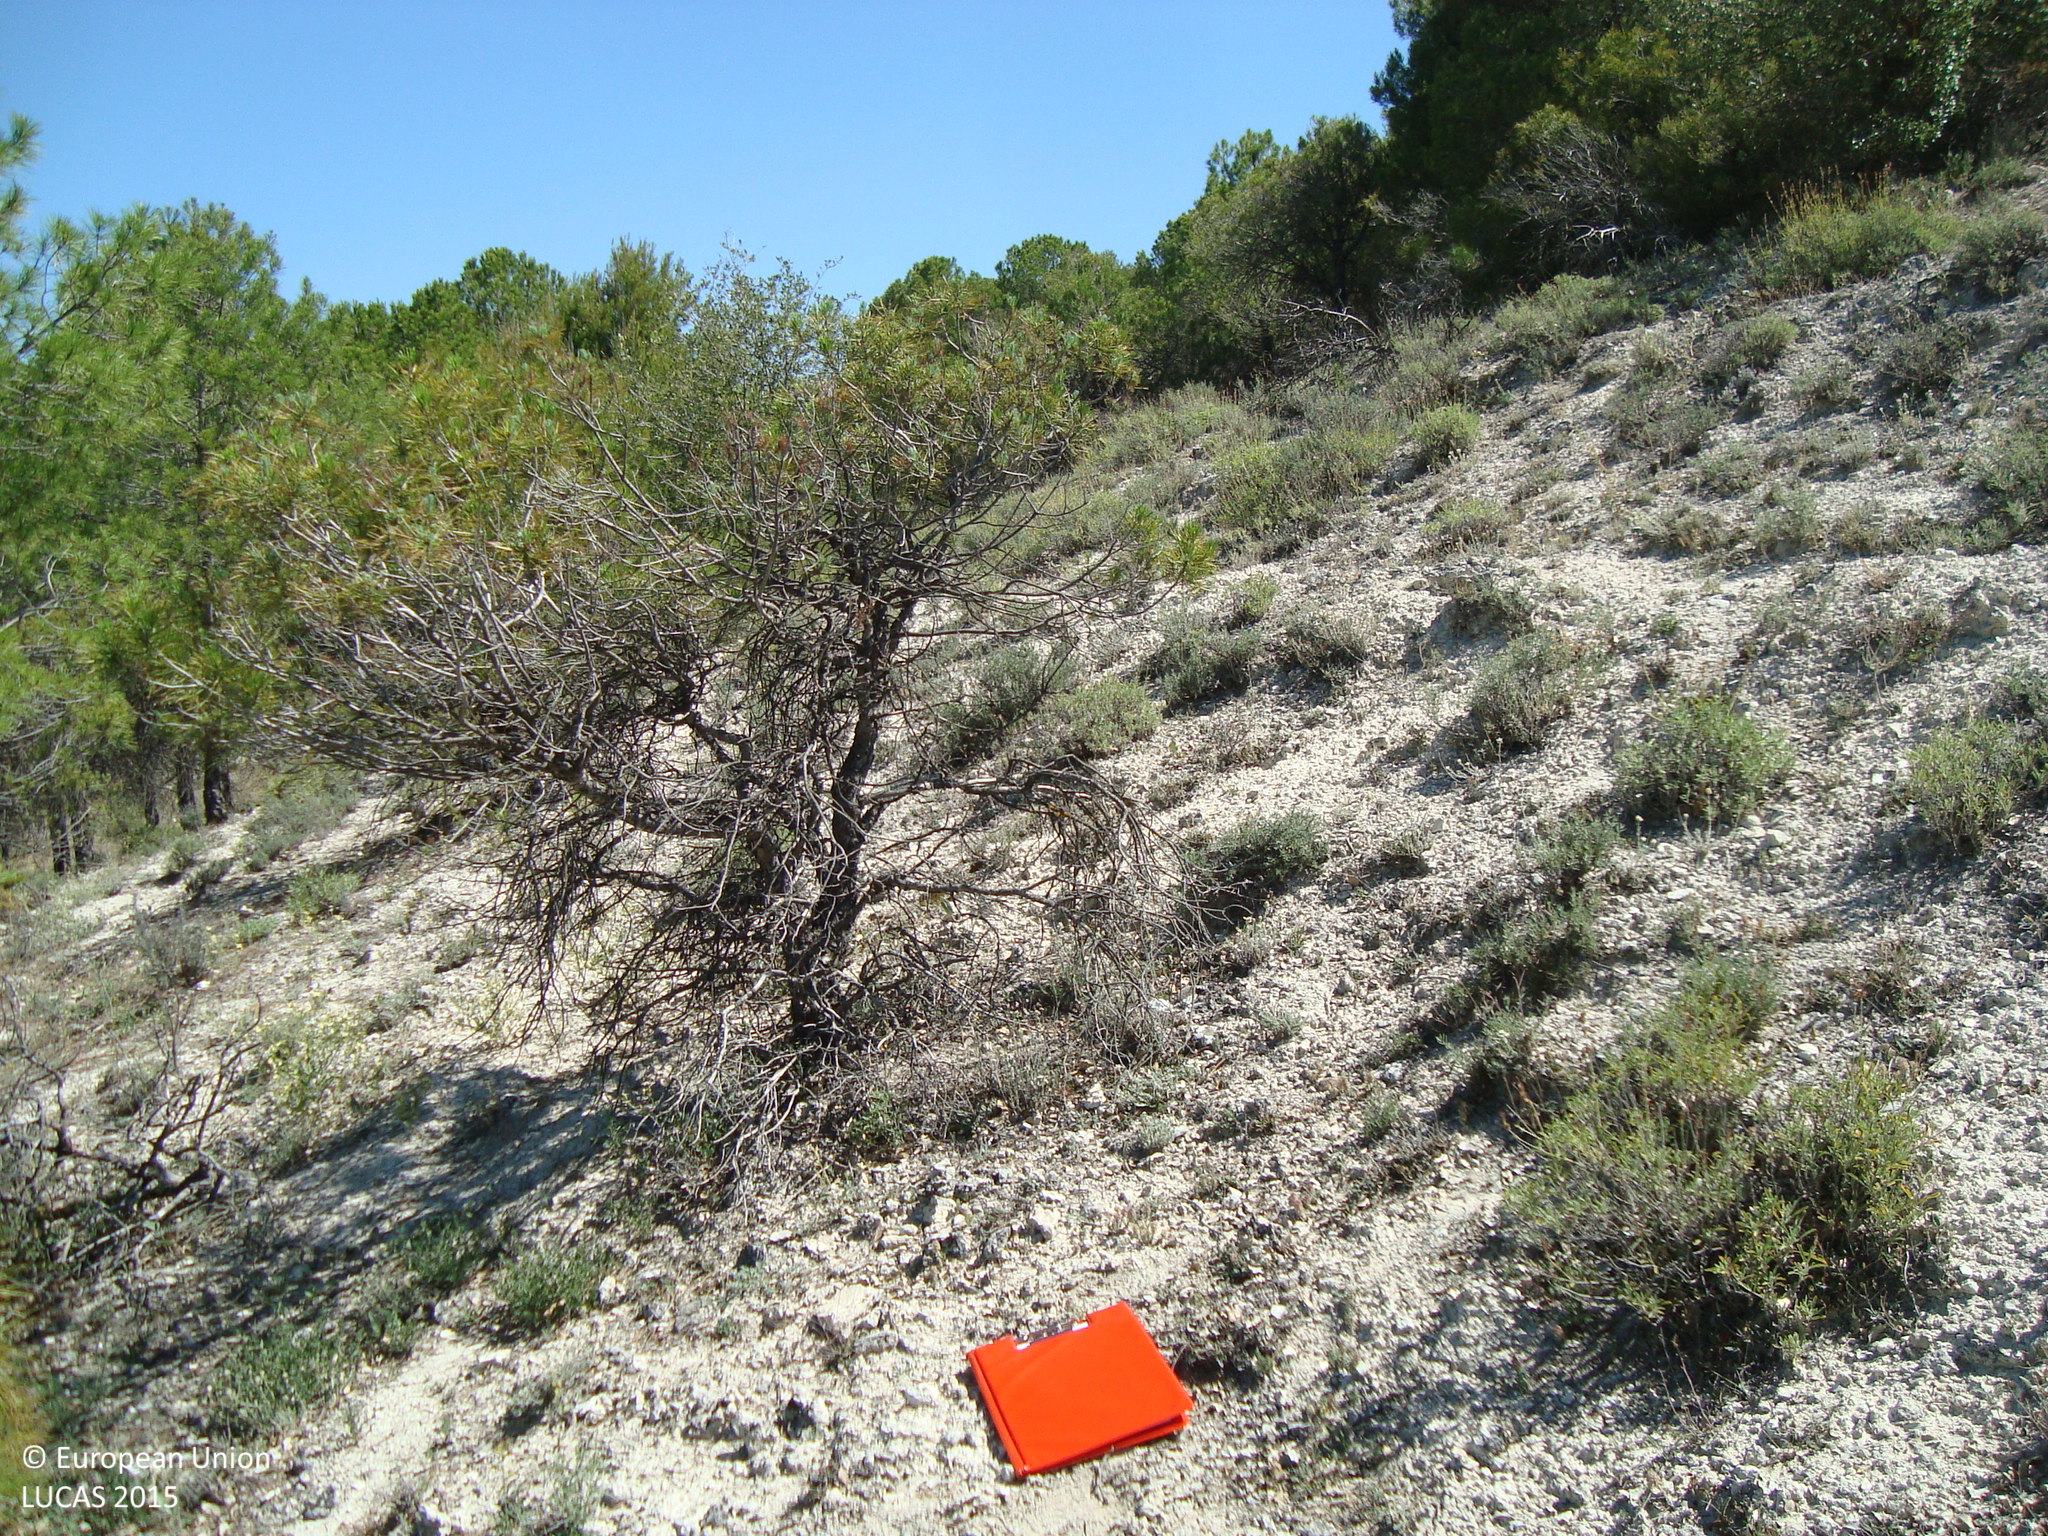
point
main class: Woodland
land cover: Pine dominated mixed woodland
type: coniferous forest of the mediterranean region
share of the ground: 50 - 75 %
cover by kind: coniferous forest trees 40 %, unconsolidated bare surface 25 %, shrubs 20 %, broadleaved forest trees 15 %
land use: Forestry
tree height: > 5 m
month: June
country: ES
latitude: 41.3854
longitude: -4.6173
